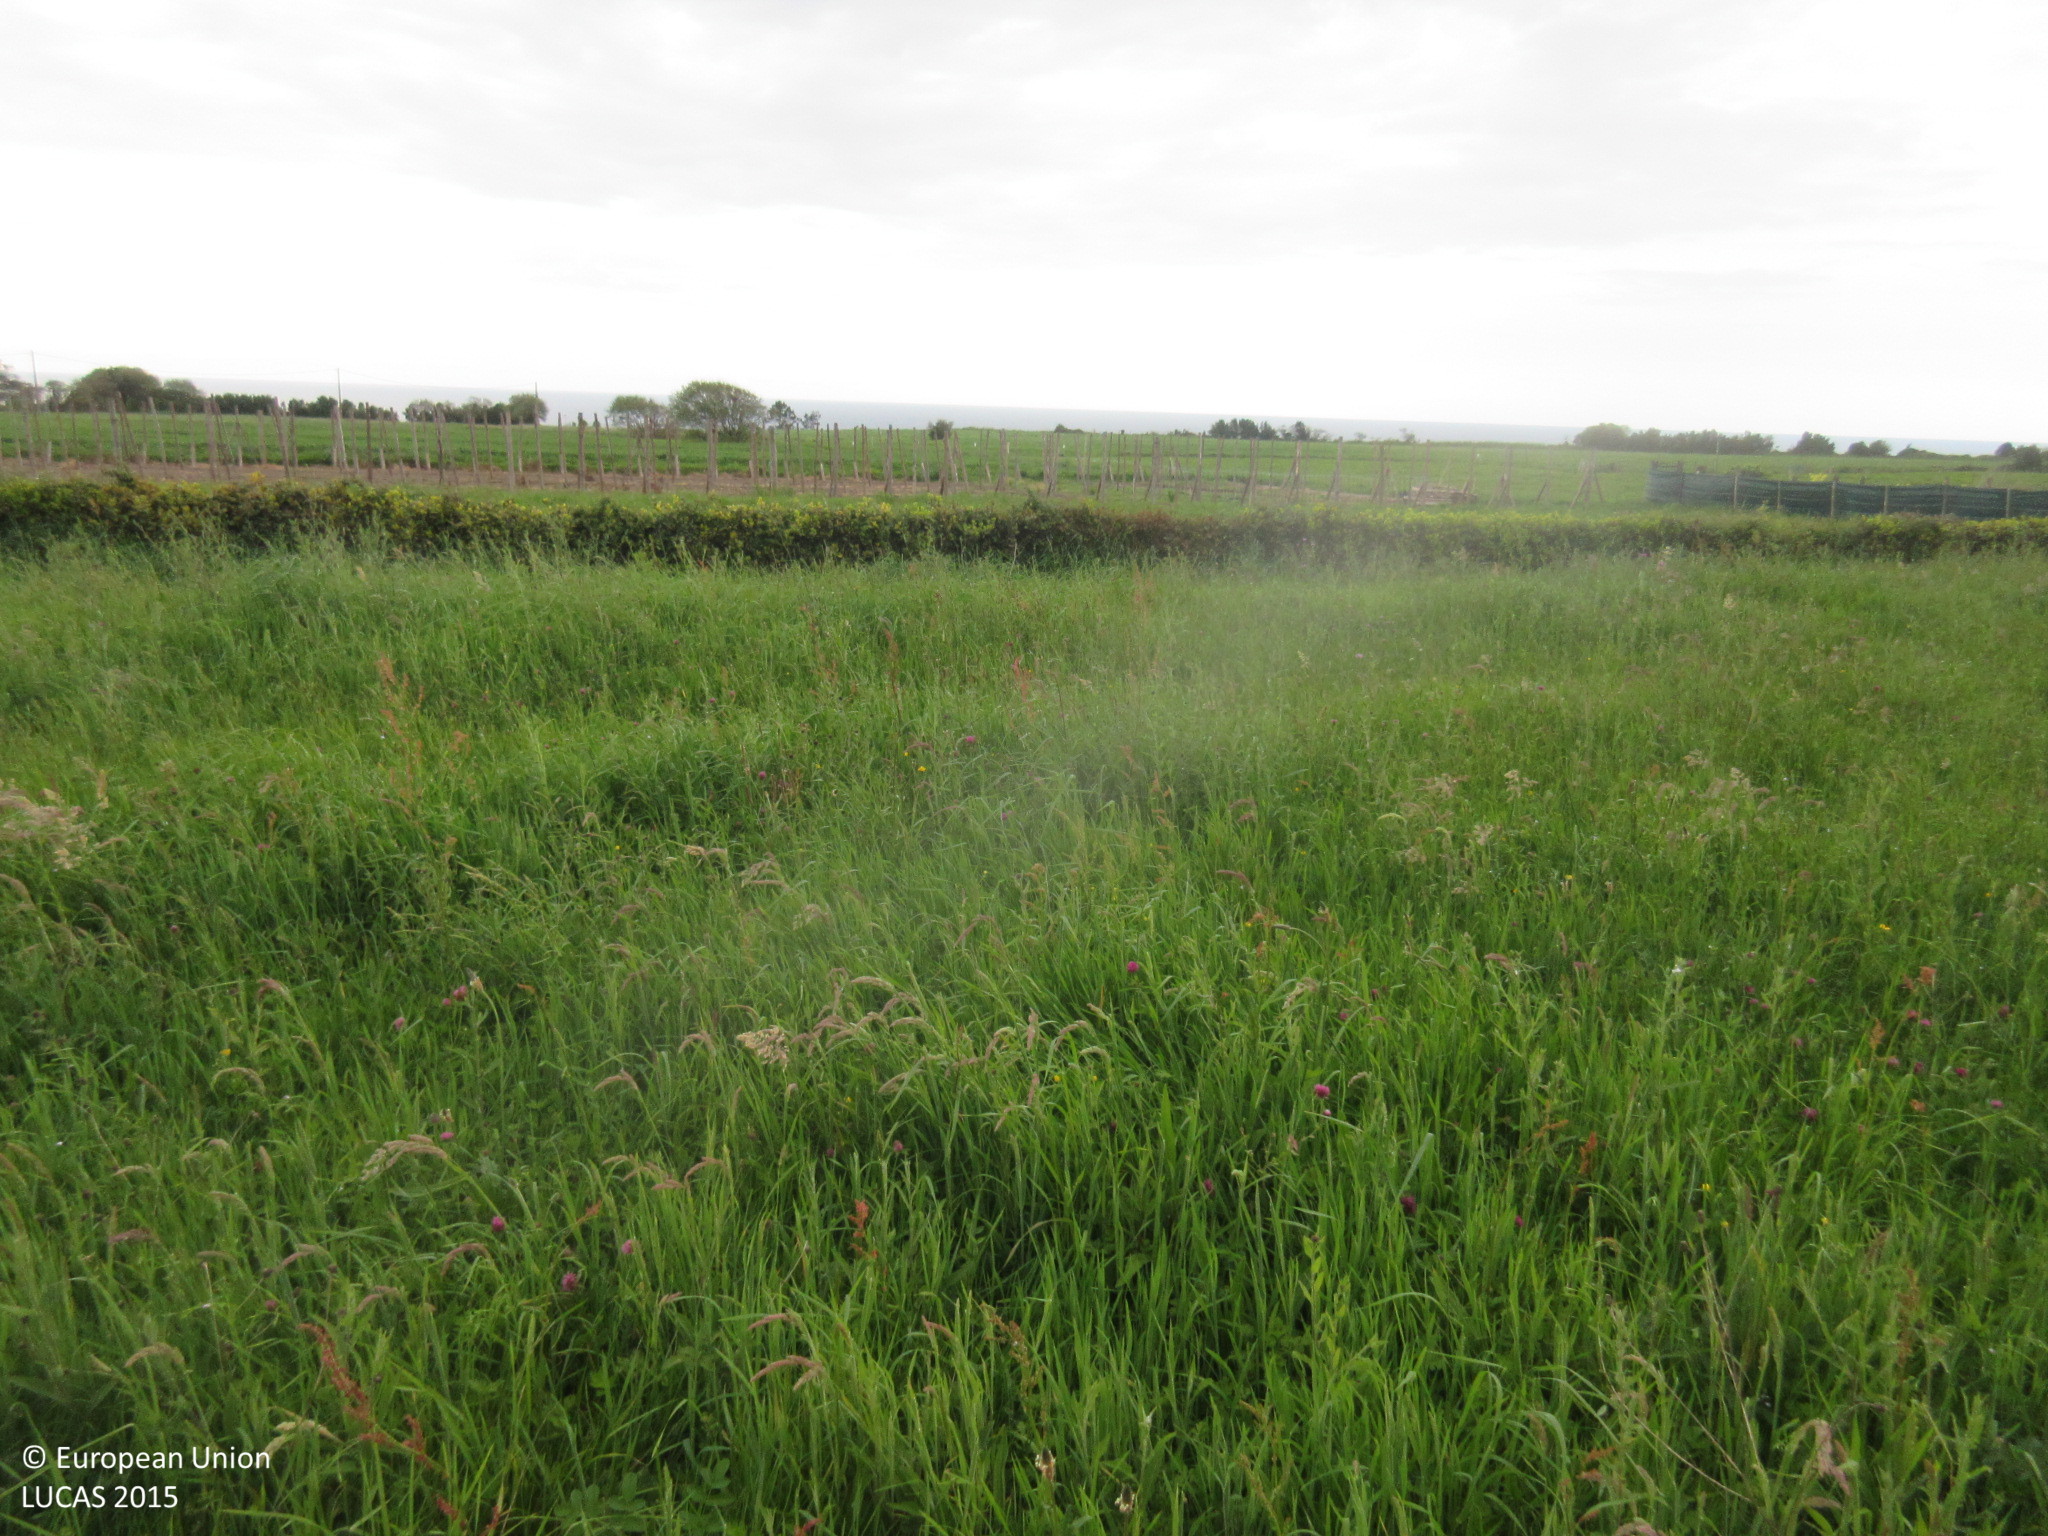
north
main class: Grassland
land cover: Grassland without tree/shrub cover
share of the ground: > 75 %
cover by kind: herbaceous plants 100 %
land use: Agriculture (excluding fallow land and kitchen gardens)
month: April
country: ES
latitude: 43.5528
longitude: -6.3797
